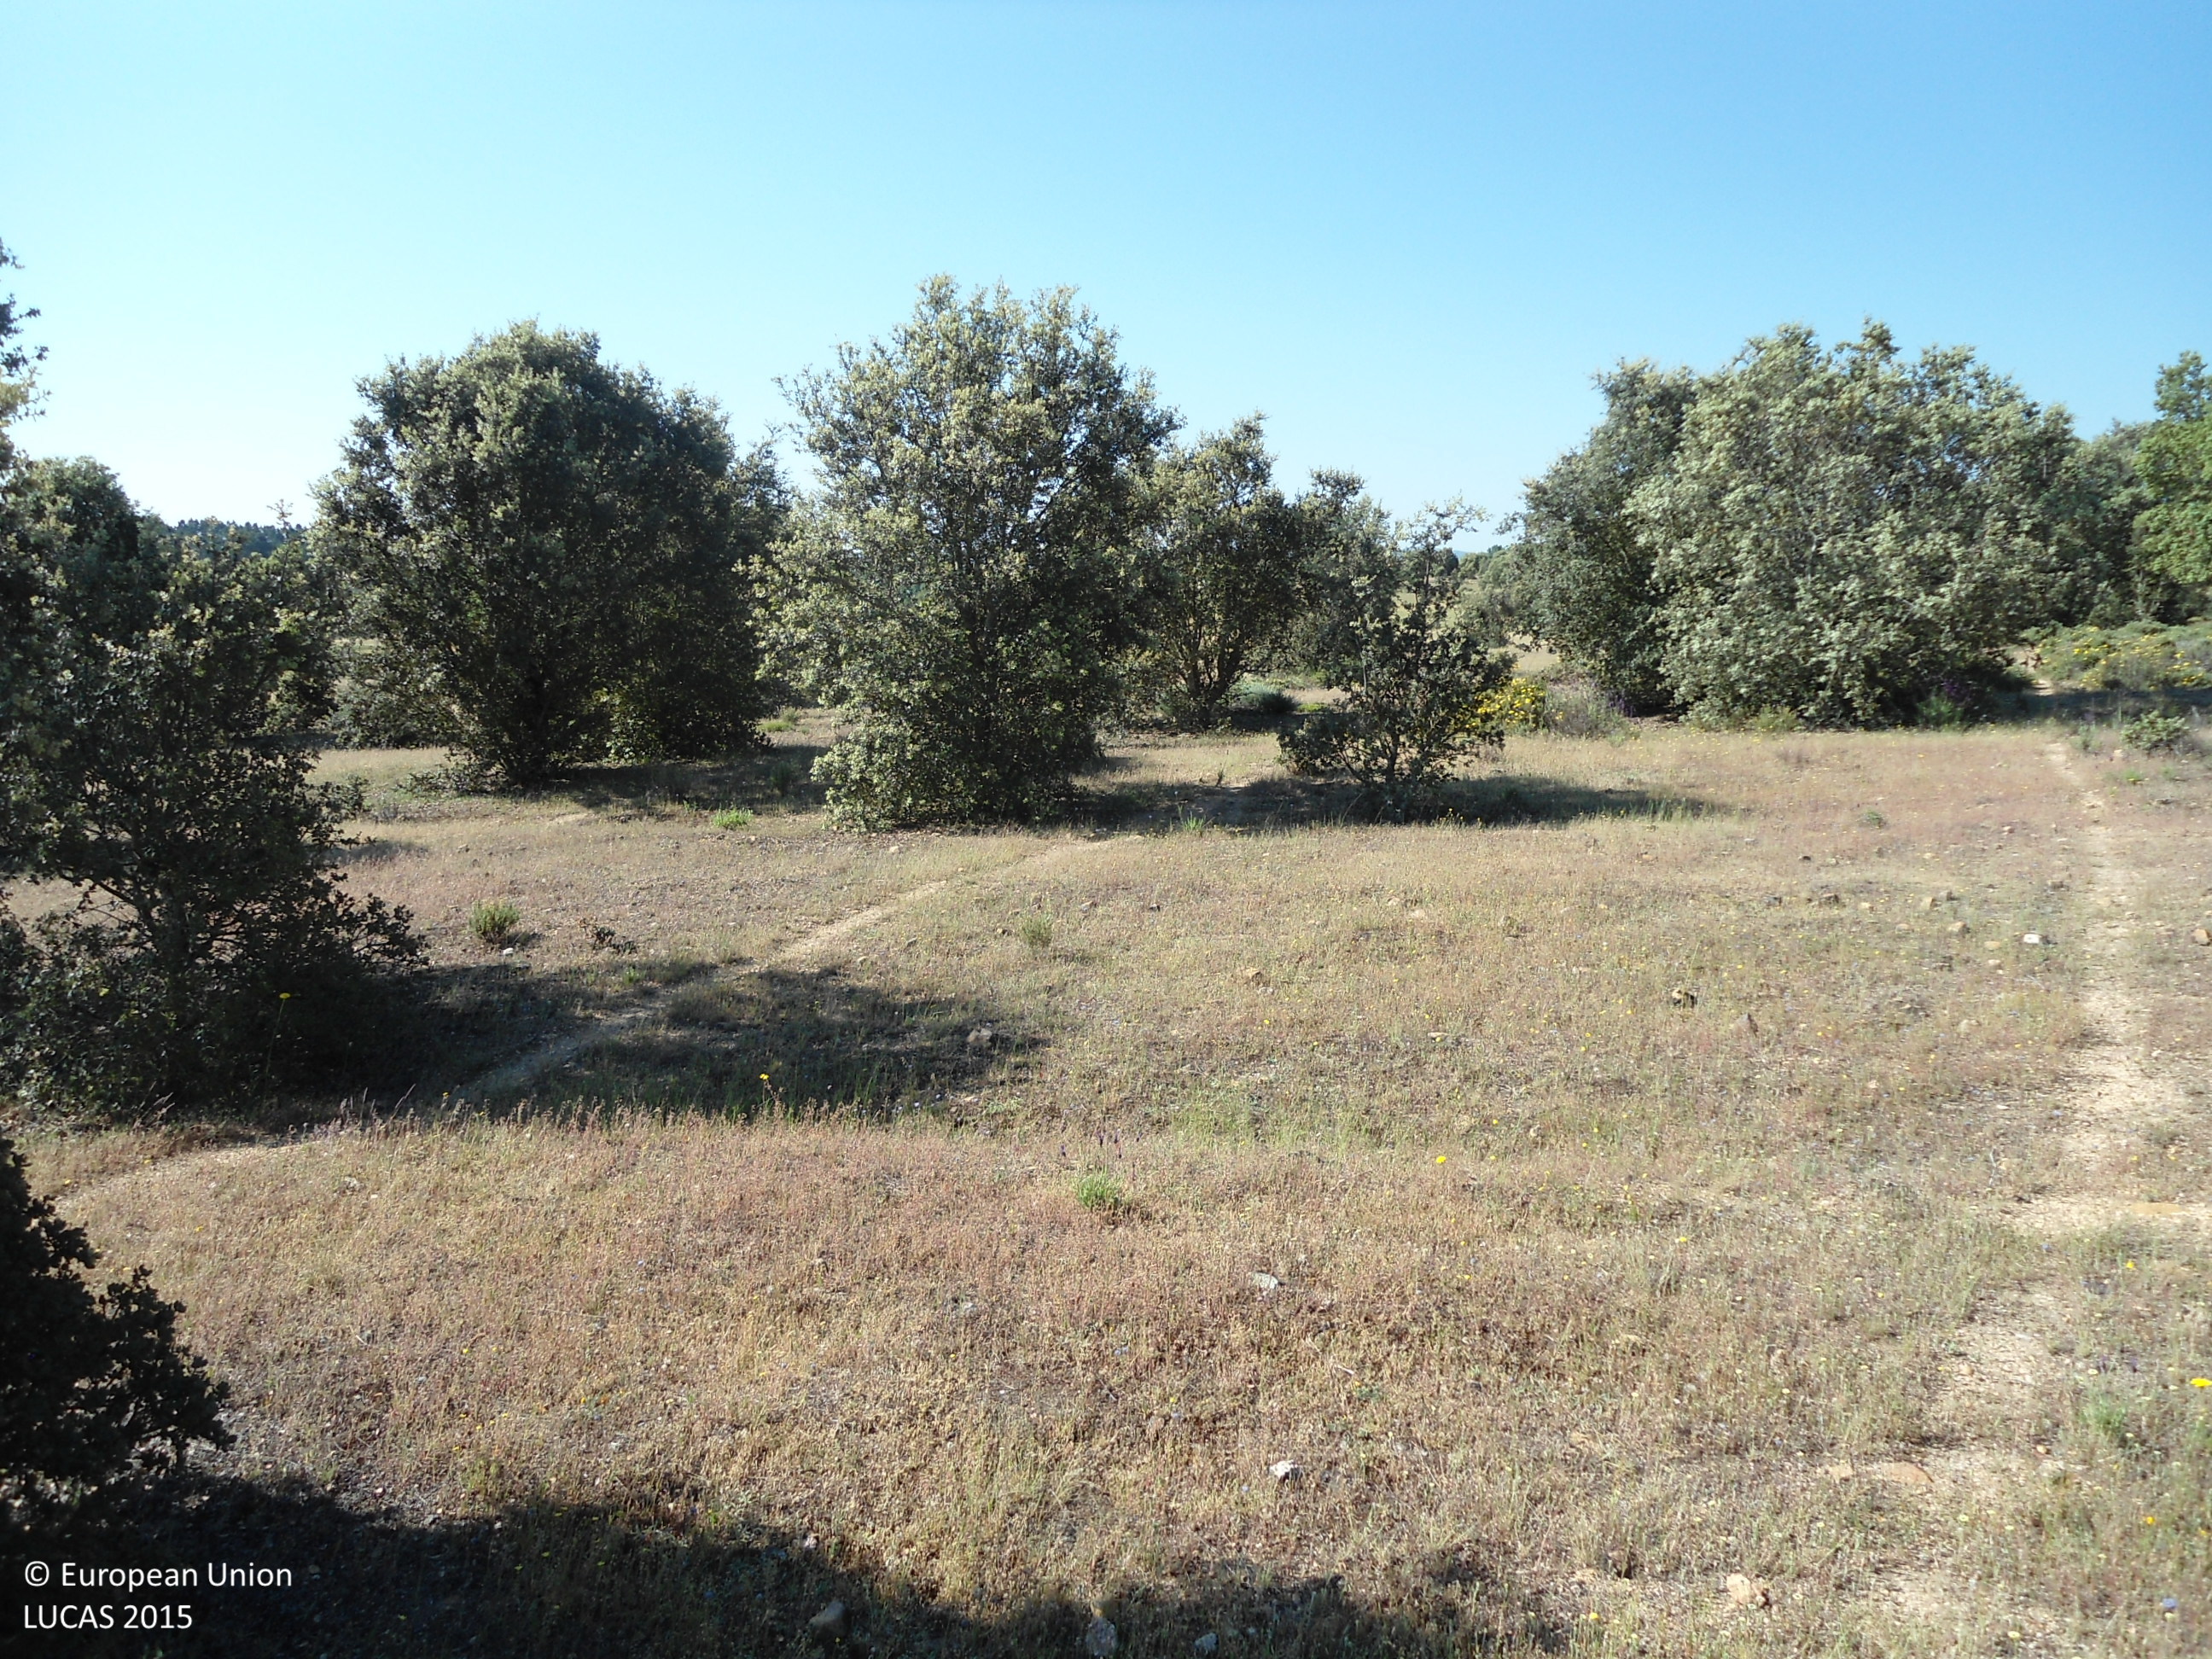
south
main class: Grassland
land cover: Grassland with sparse tree/shrub cover
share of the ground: 50 - 75 %
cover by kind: herbaceous plants 85 %, shrubs 10 %, broadleaved forest trees 5 %
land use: Agriculture (excluding fallow land and kitchen gardens)
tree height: < 5 m
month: June
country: ES
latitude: 42.0335
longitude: -6.2297
